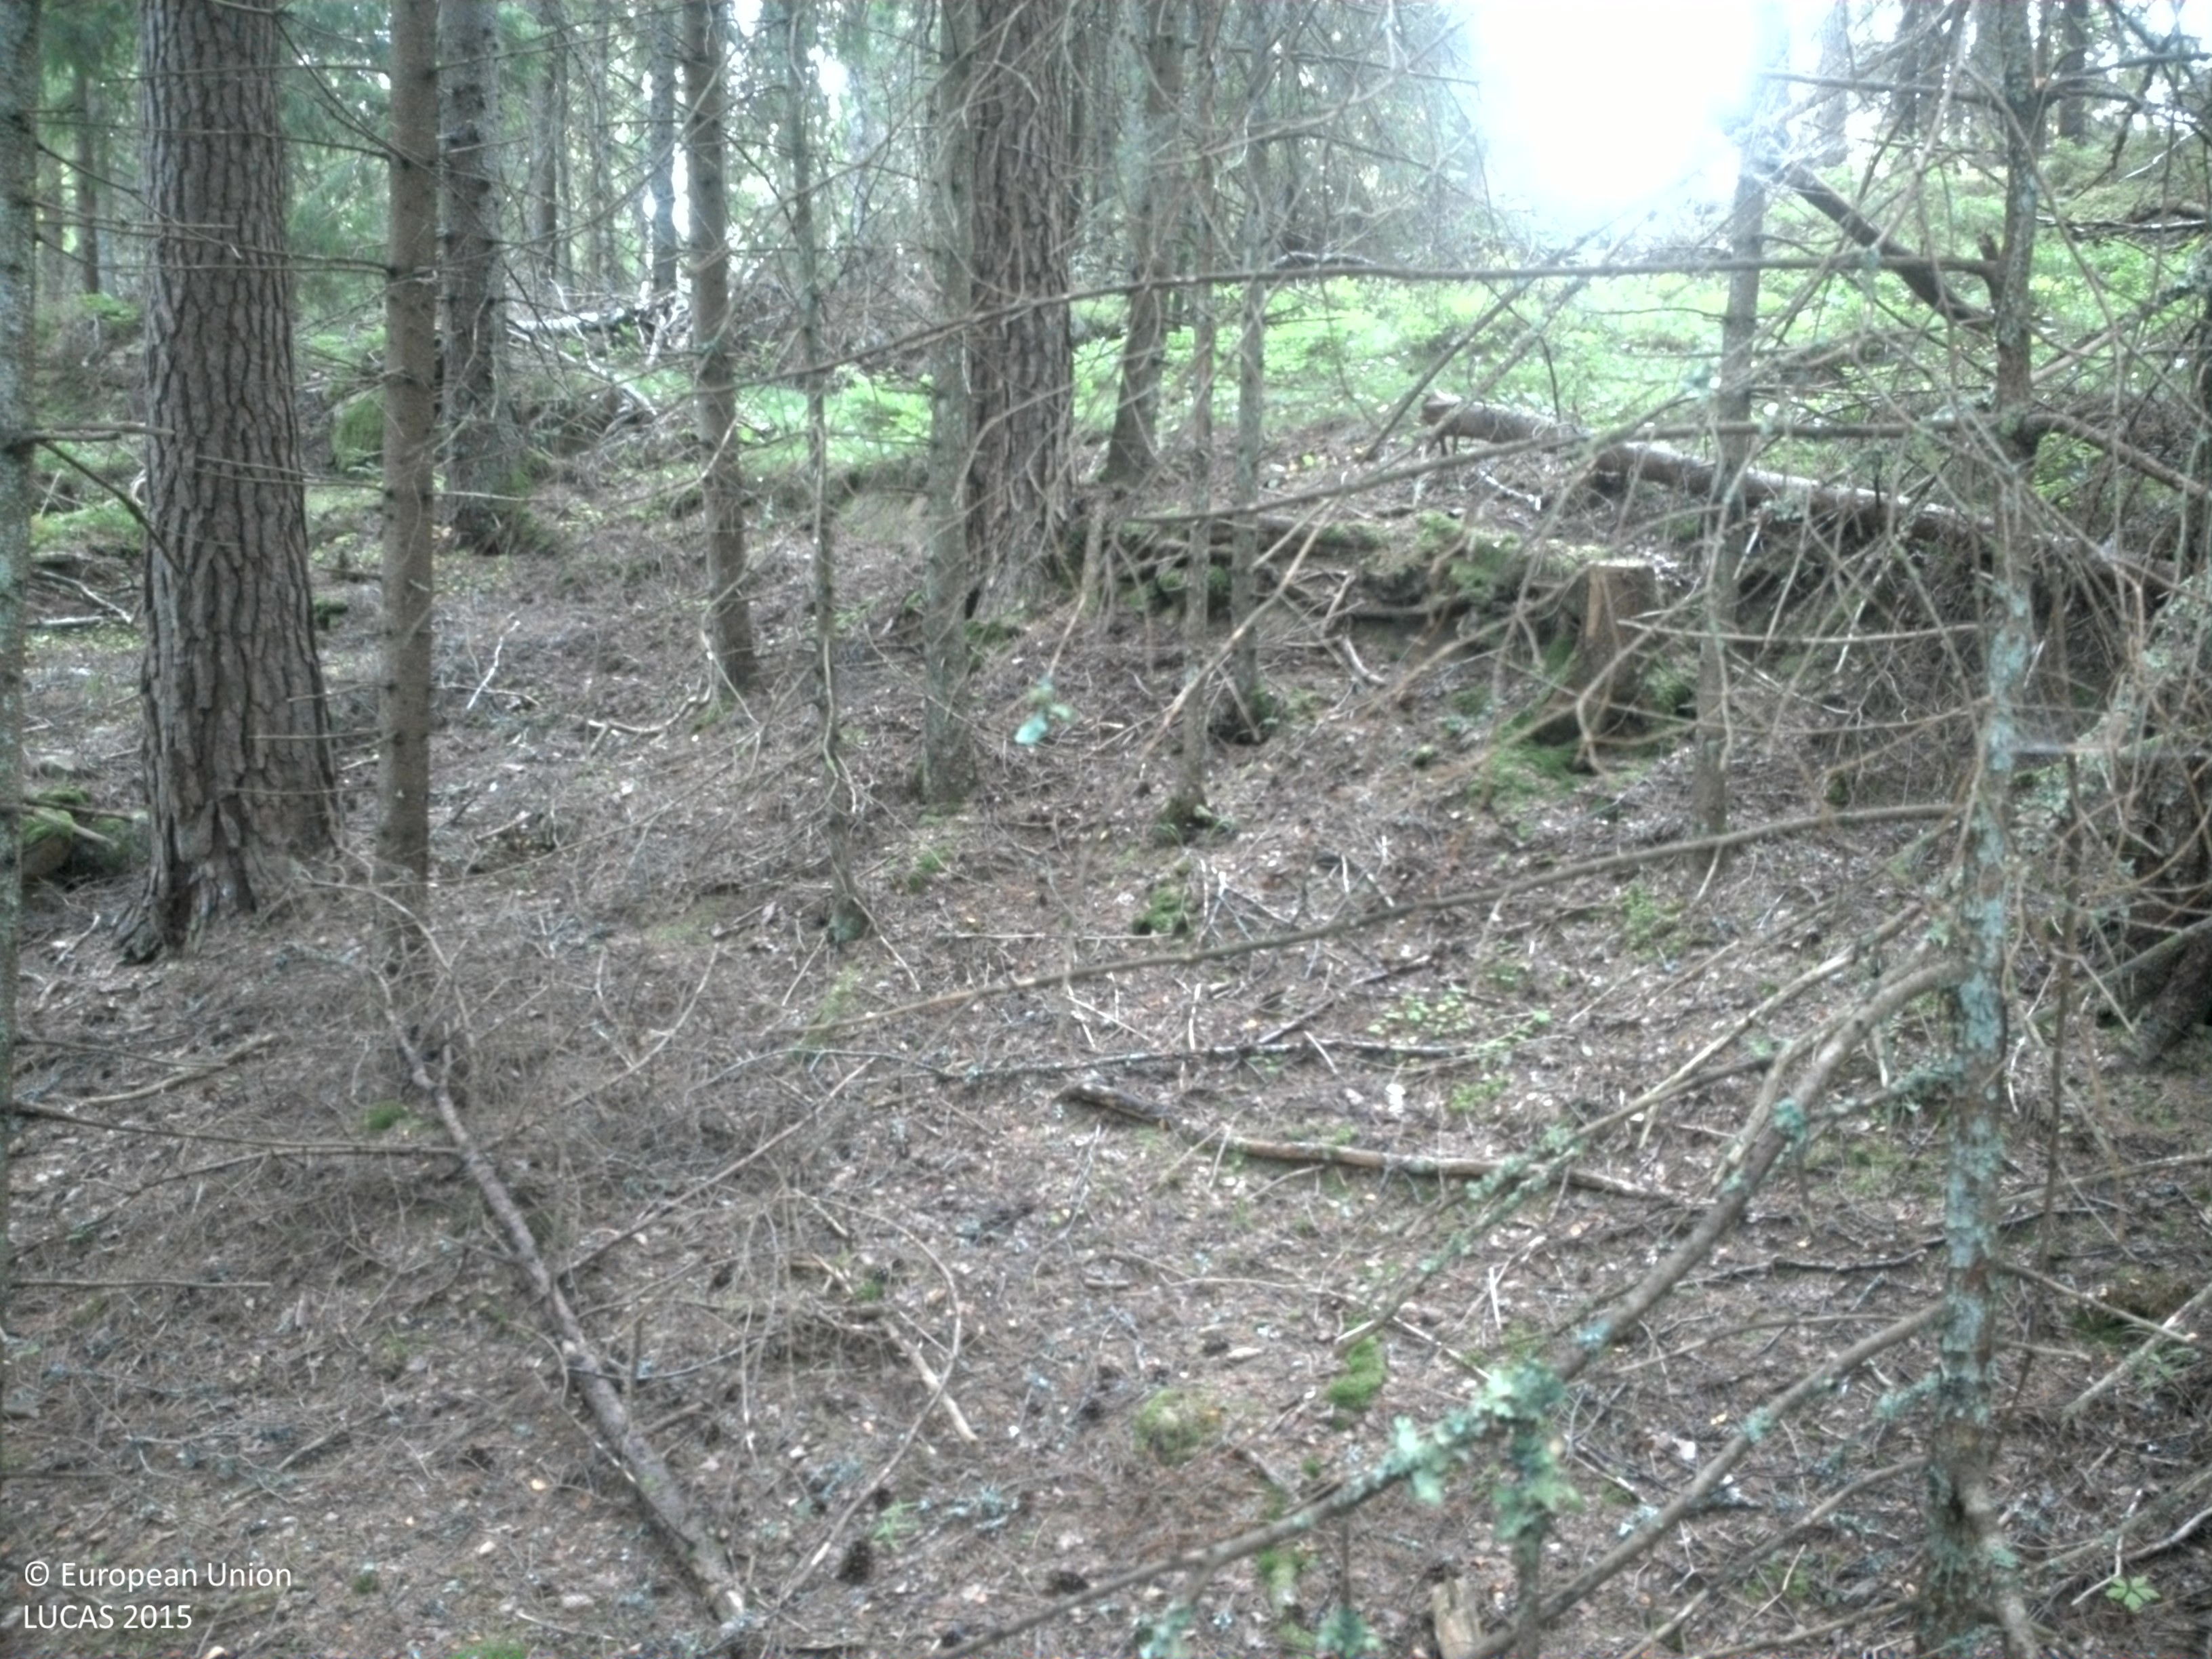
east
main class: Woodland
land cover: Spruce dominated coniferous woodland
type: boreal forest
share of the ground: 50 - 75 %
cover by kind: coniferous forest trees 70 %, unconsolidated bare surface 10 %, broadleaved forest trees 5 %, shrubs 5 %, herbaceous plants 5 %, lichens and mosses 5 %
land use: Forestry
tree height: > 5 m
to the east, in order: Spruce dominated coniferous woodland; Tracks; Spruce dominated coniferous woodland; Grassland with sparse tree/shrub cover; Broadleaved woodland; Grassland without tree/shrub cover; Spruce dominated mixed woodland
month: August
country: SE
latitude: 58.0367
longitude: 13.9069
